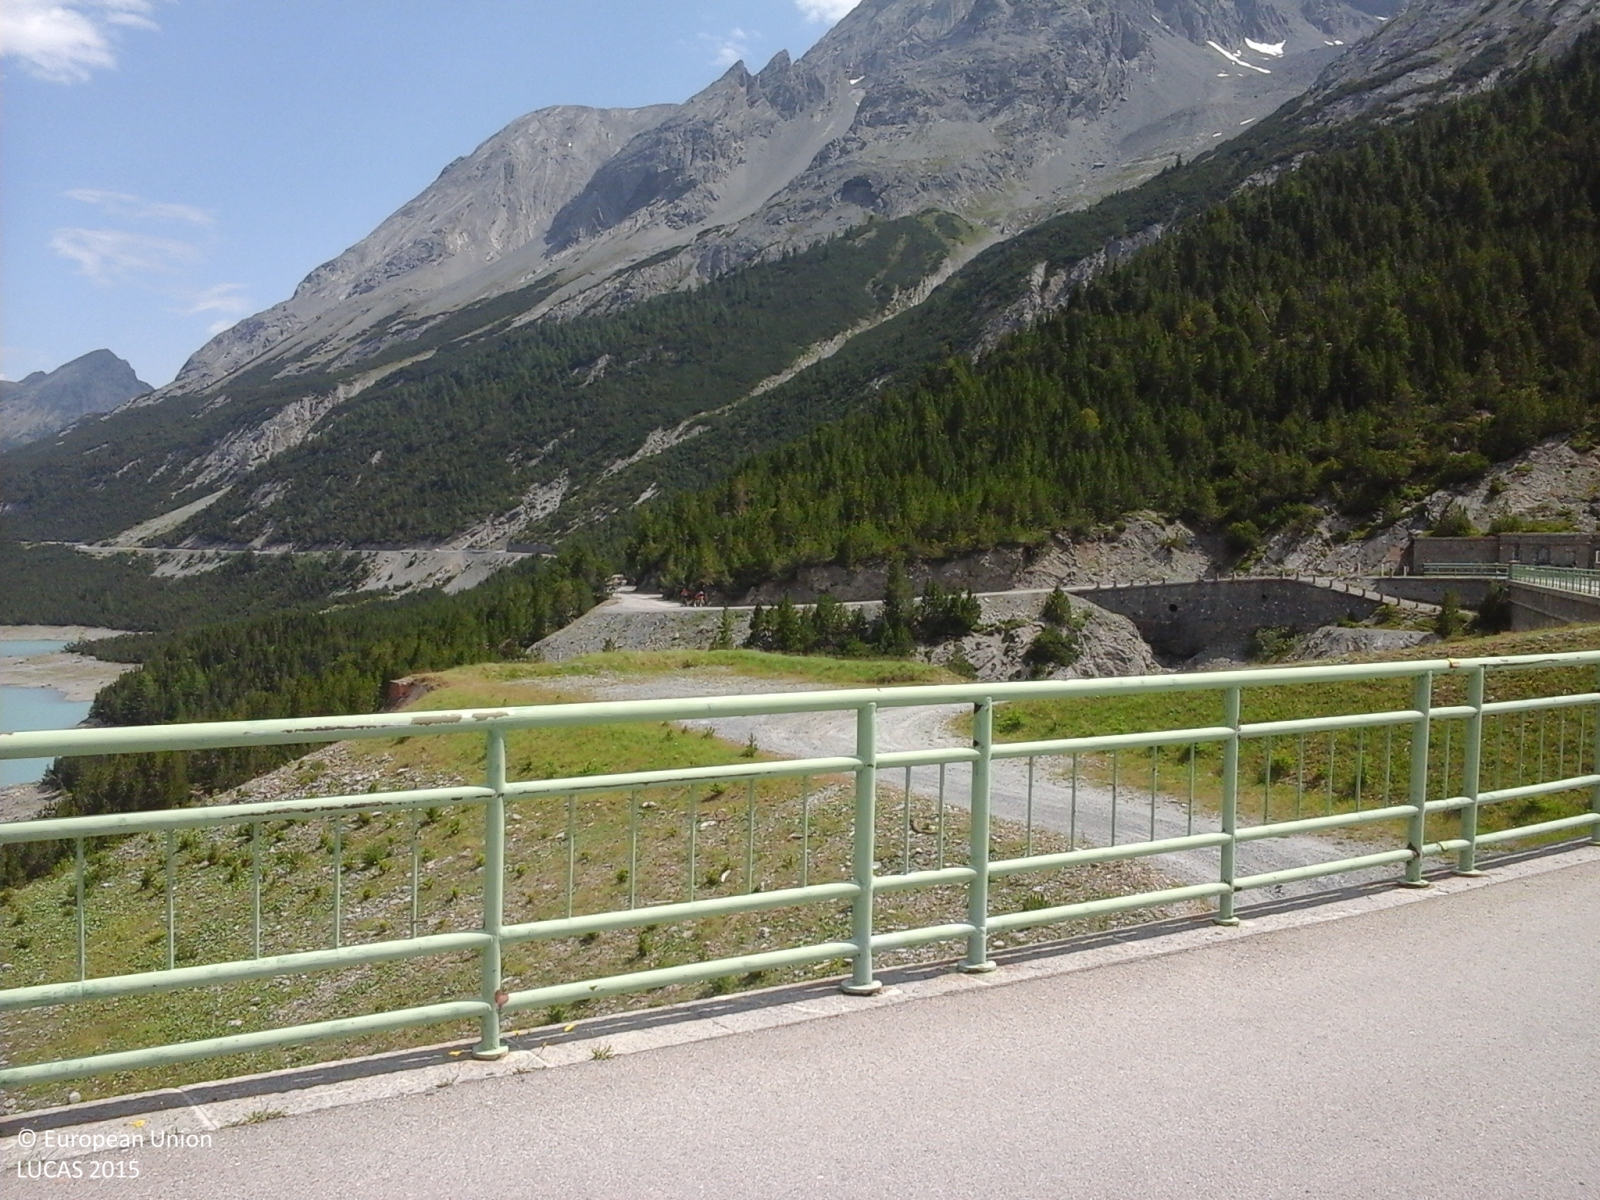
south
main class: Woodland
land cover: Spruce dominated coniferous woodland
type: alpine coniferous forest
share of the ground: > 75 %
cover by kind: coniferous forest trees 100 %
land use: Semi-natural and natural areas not in use
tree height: > 5 m
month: July
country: IT
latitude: 46.5310
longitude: 10.2734
